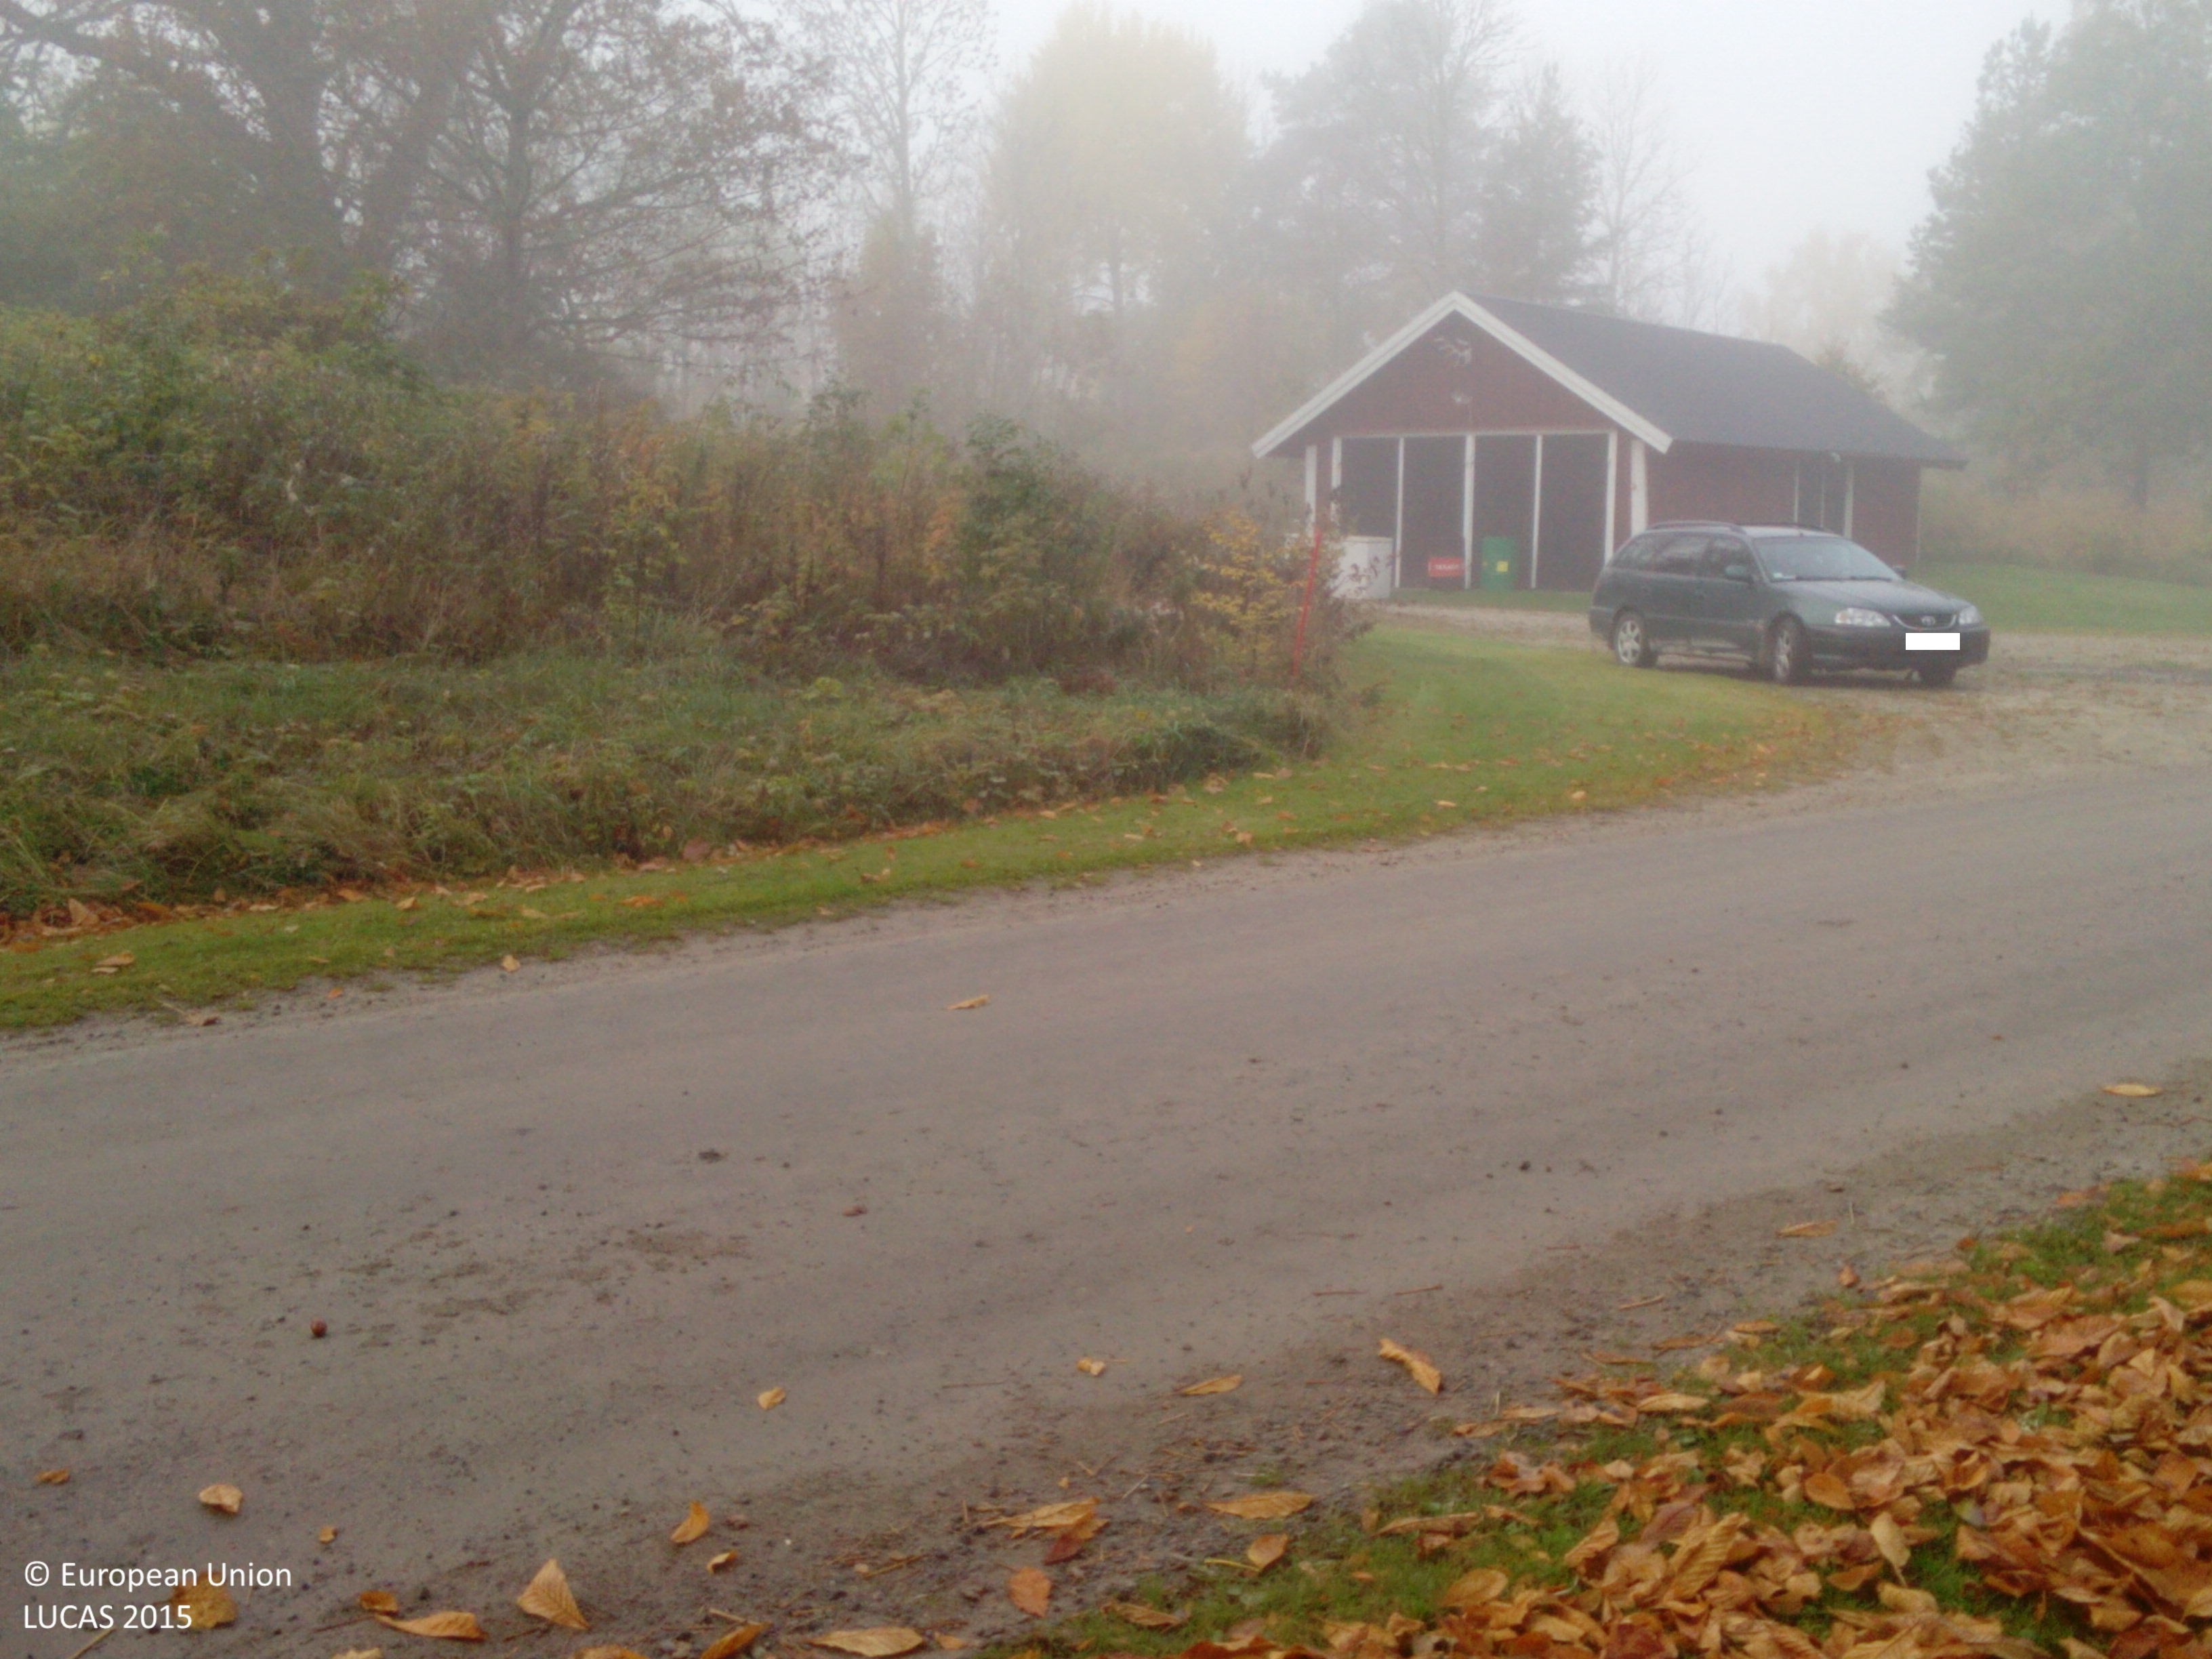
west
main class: Grassland
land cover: Grassland with sparse tree/shrub cover
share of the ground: > 75 %
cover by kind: herbaceous plants 70 %, consolidated bare surface 15 %, broadleaved forest trees 5 %
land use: Residential
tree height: > 5 m
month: October
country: SE
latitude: 58.9659
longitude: 16.4810
